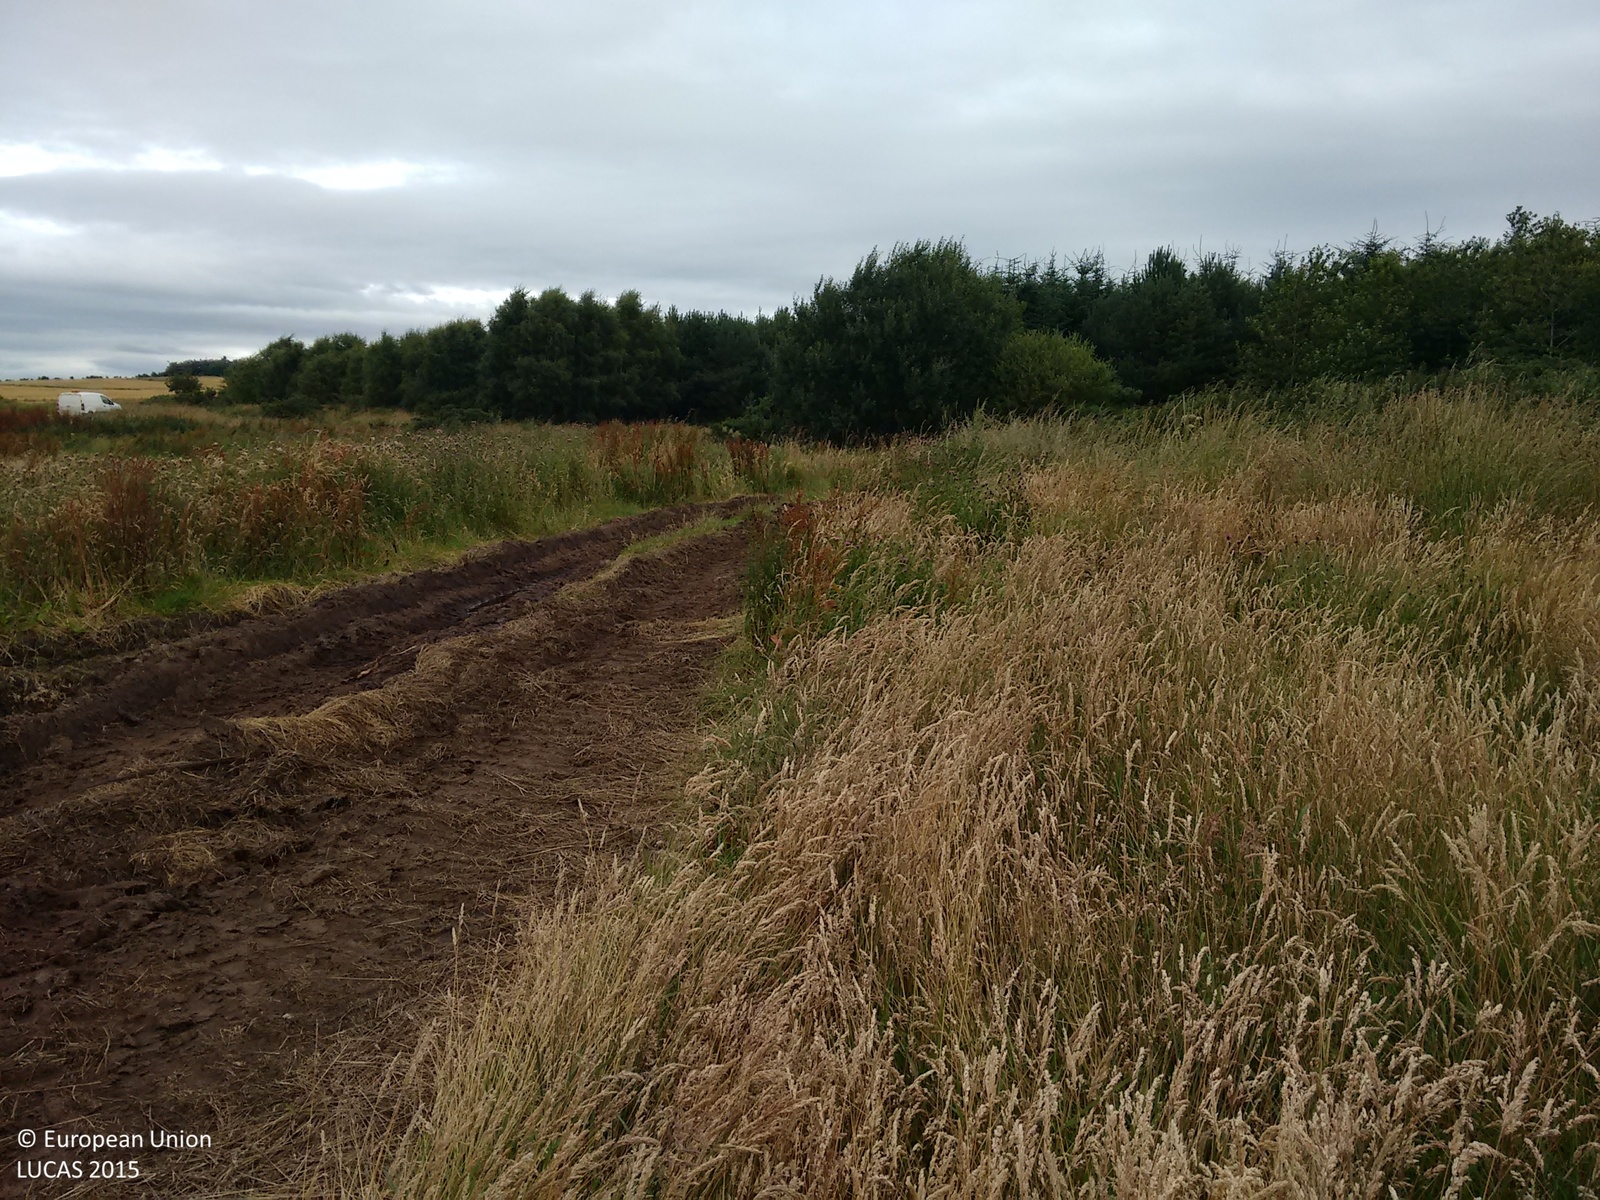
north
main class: Grassland
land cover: Grassland without tree/shrub cover
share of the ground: > 75 %
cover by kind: herbaceous plants 100 %
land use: Forestry
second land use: Agriculture (excluding fallow land and kitchen gardens)
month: August
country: GB
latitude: 57.8007
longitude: -3.9248
